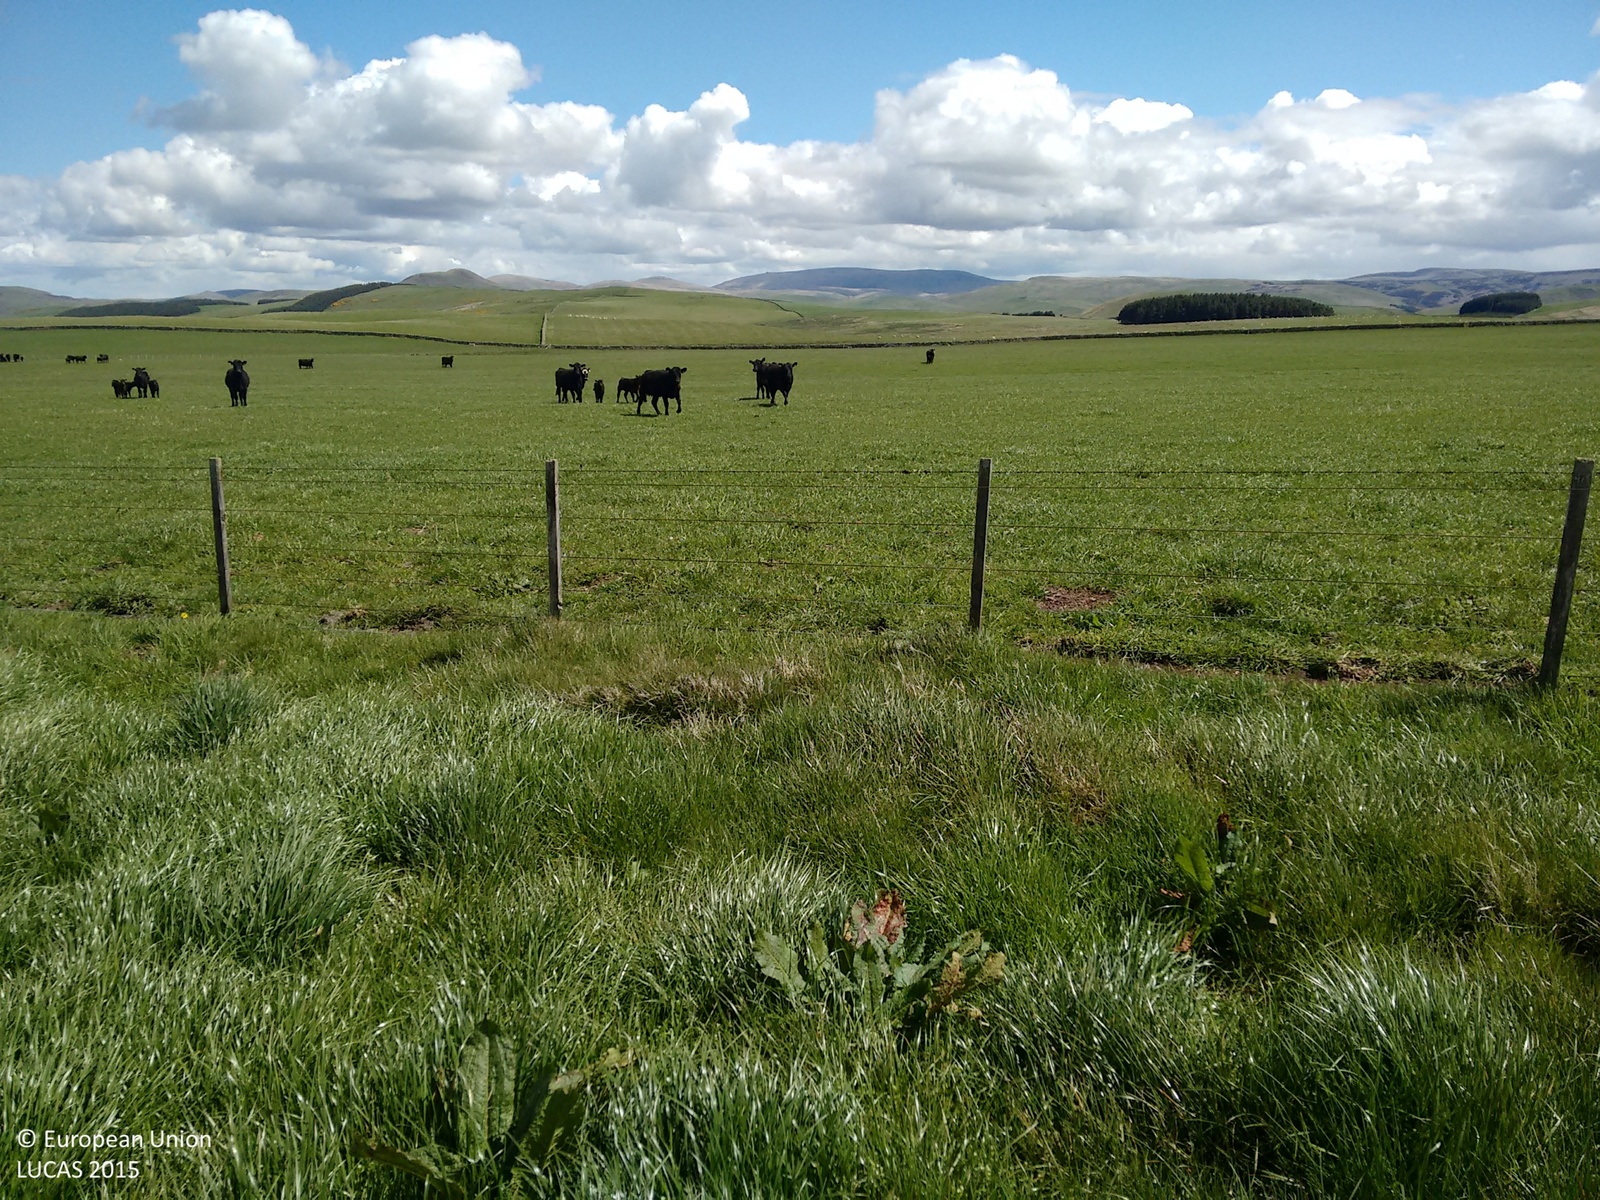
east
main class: Grassland
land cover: Grassland without tree/shrub cover
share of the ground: > 75 %
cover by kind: herbaceous plants 100 %
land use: Agriculture (excluding fallow land and kitchen gardens)
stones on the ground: < 10 %
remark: Harvested field
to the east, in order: Grassland without tree/shrub cover; Dry stone walls
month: May
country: GB
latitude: 55.4727
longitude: -2.4149
